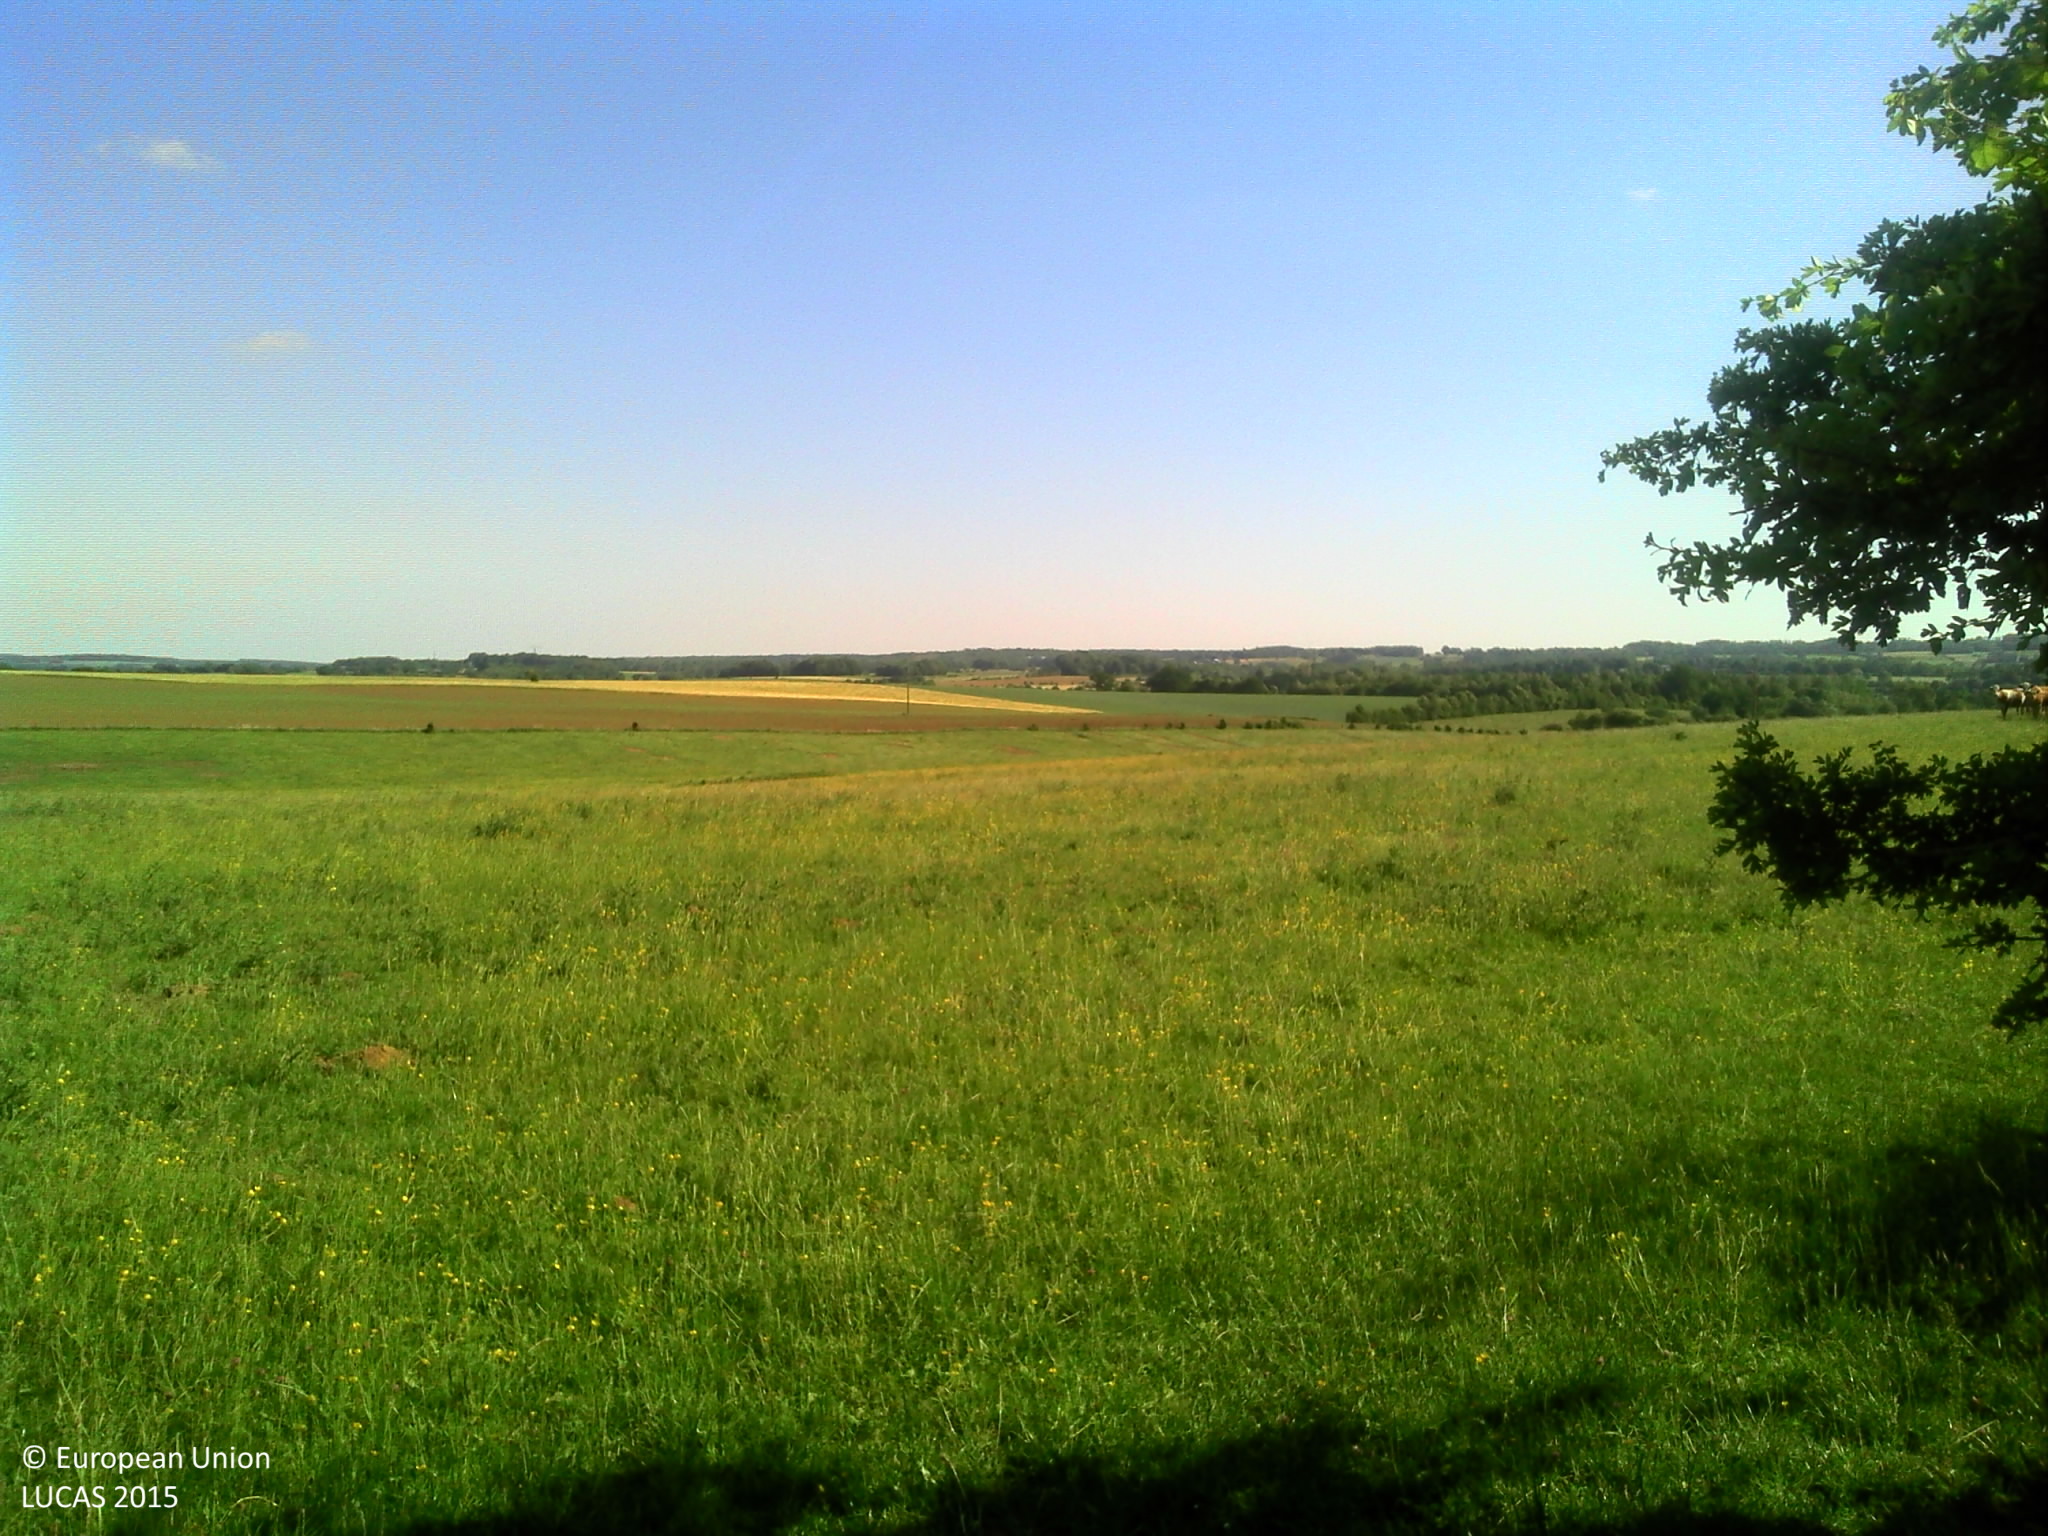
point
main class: Grassland
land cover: Grassland without tree/shrub cover
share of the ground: > 75 %
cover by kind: herbaceous plants 100 %
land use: Agriculture (excluding fallow land and kitchen gardens)
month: June
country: FR
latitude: 49.8862
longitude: 4.0795
